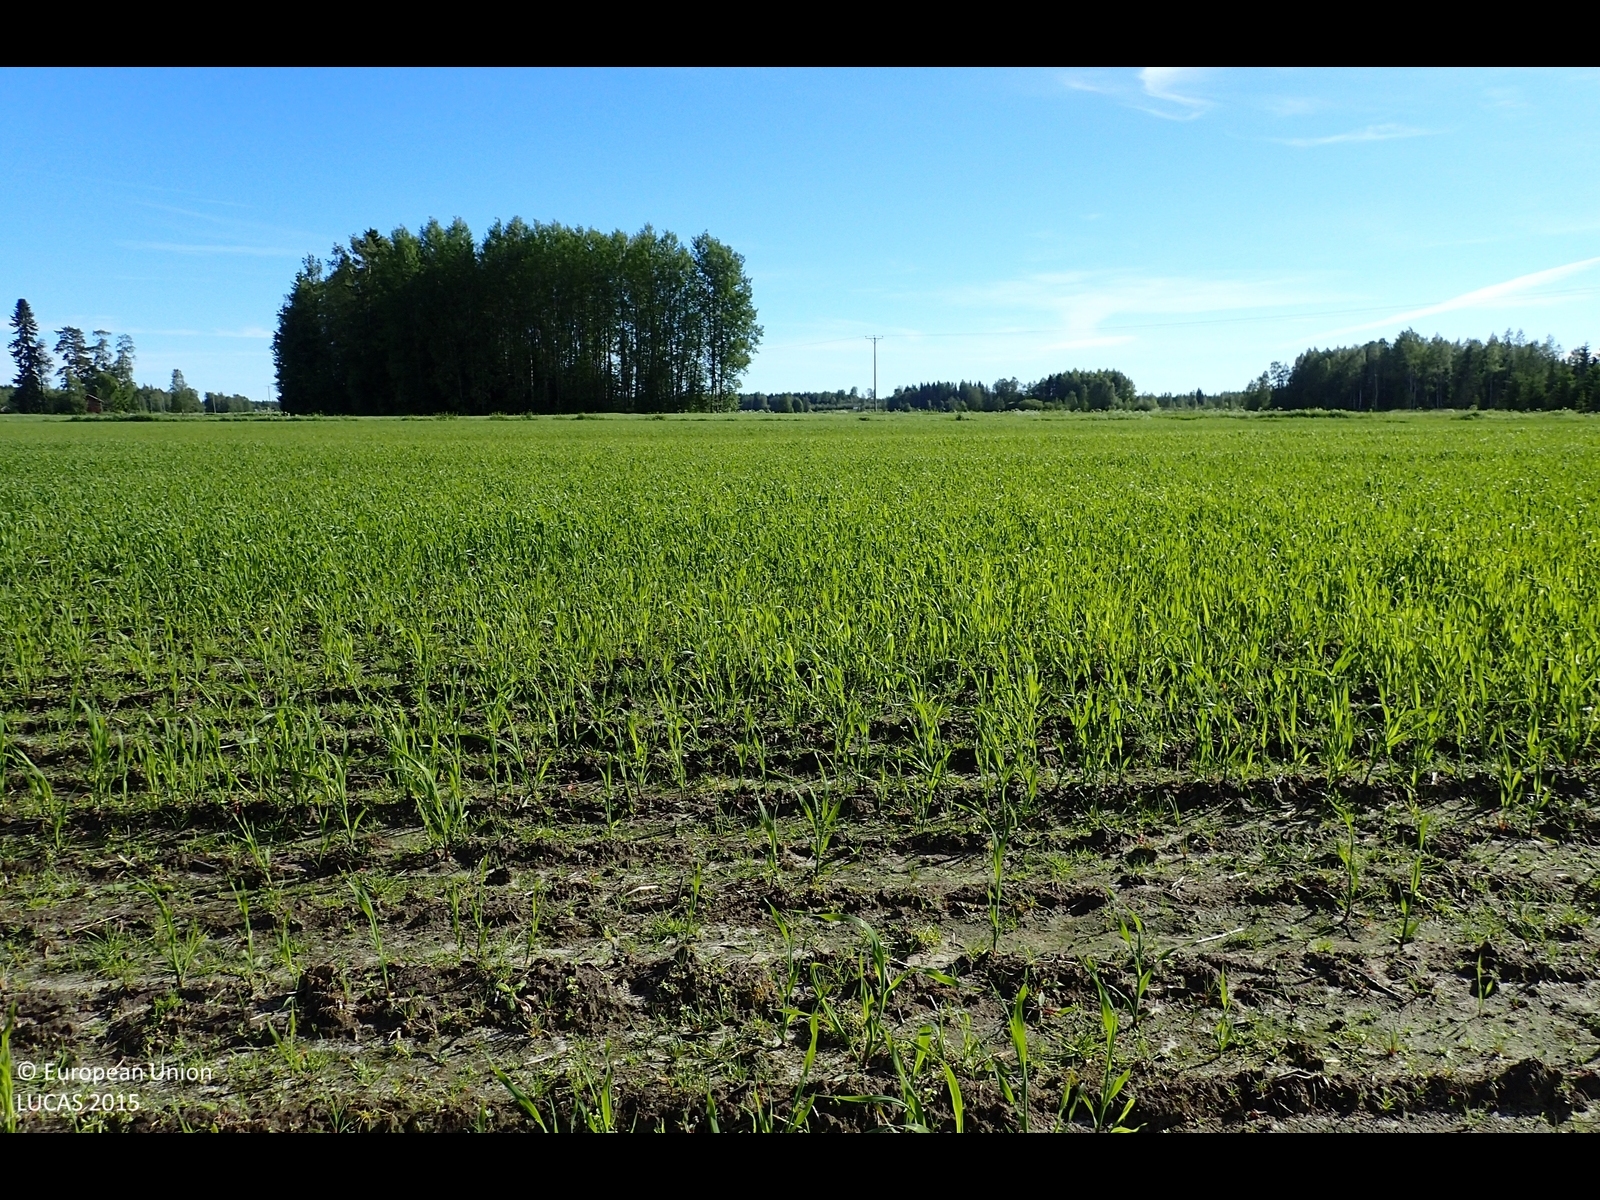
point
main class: Cropland
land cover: Oats
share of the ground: > 75 %
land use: Agriculture (excluding fallow land and kitchen gardens)
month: July
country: FI
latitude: 62.5775
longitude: 21.6640
